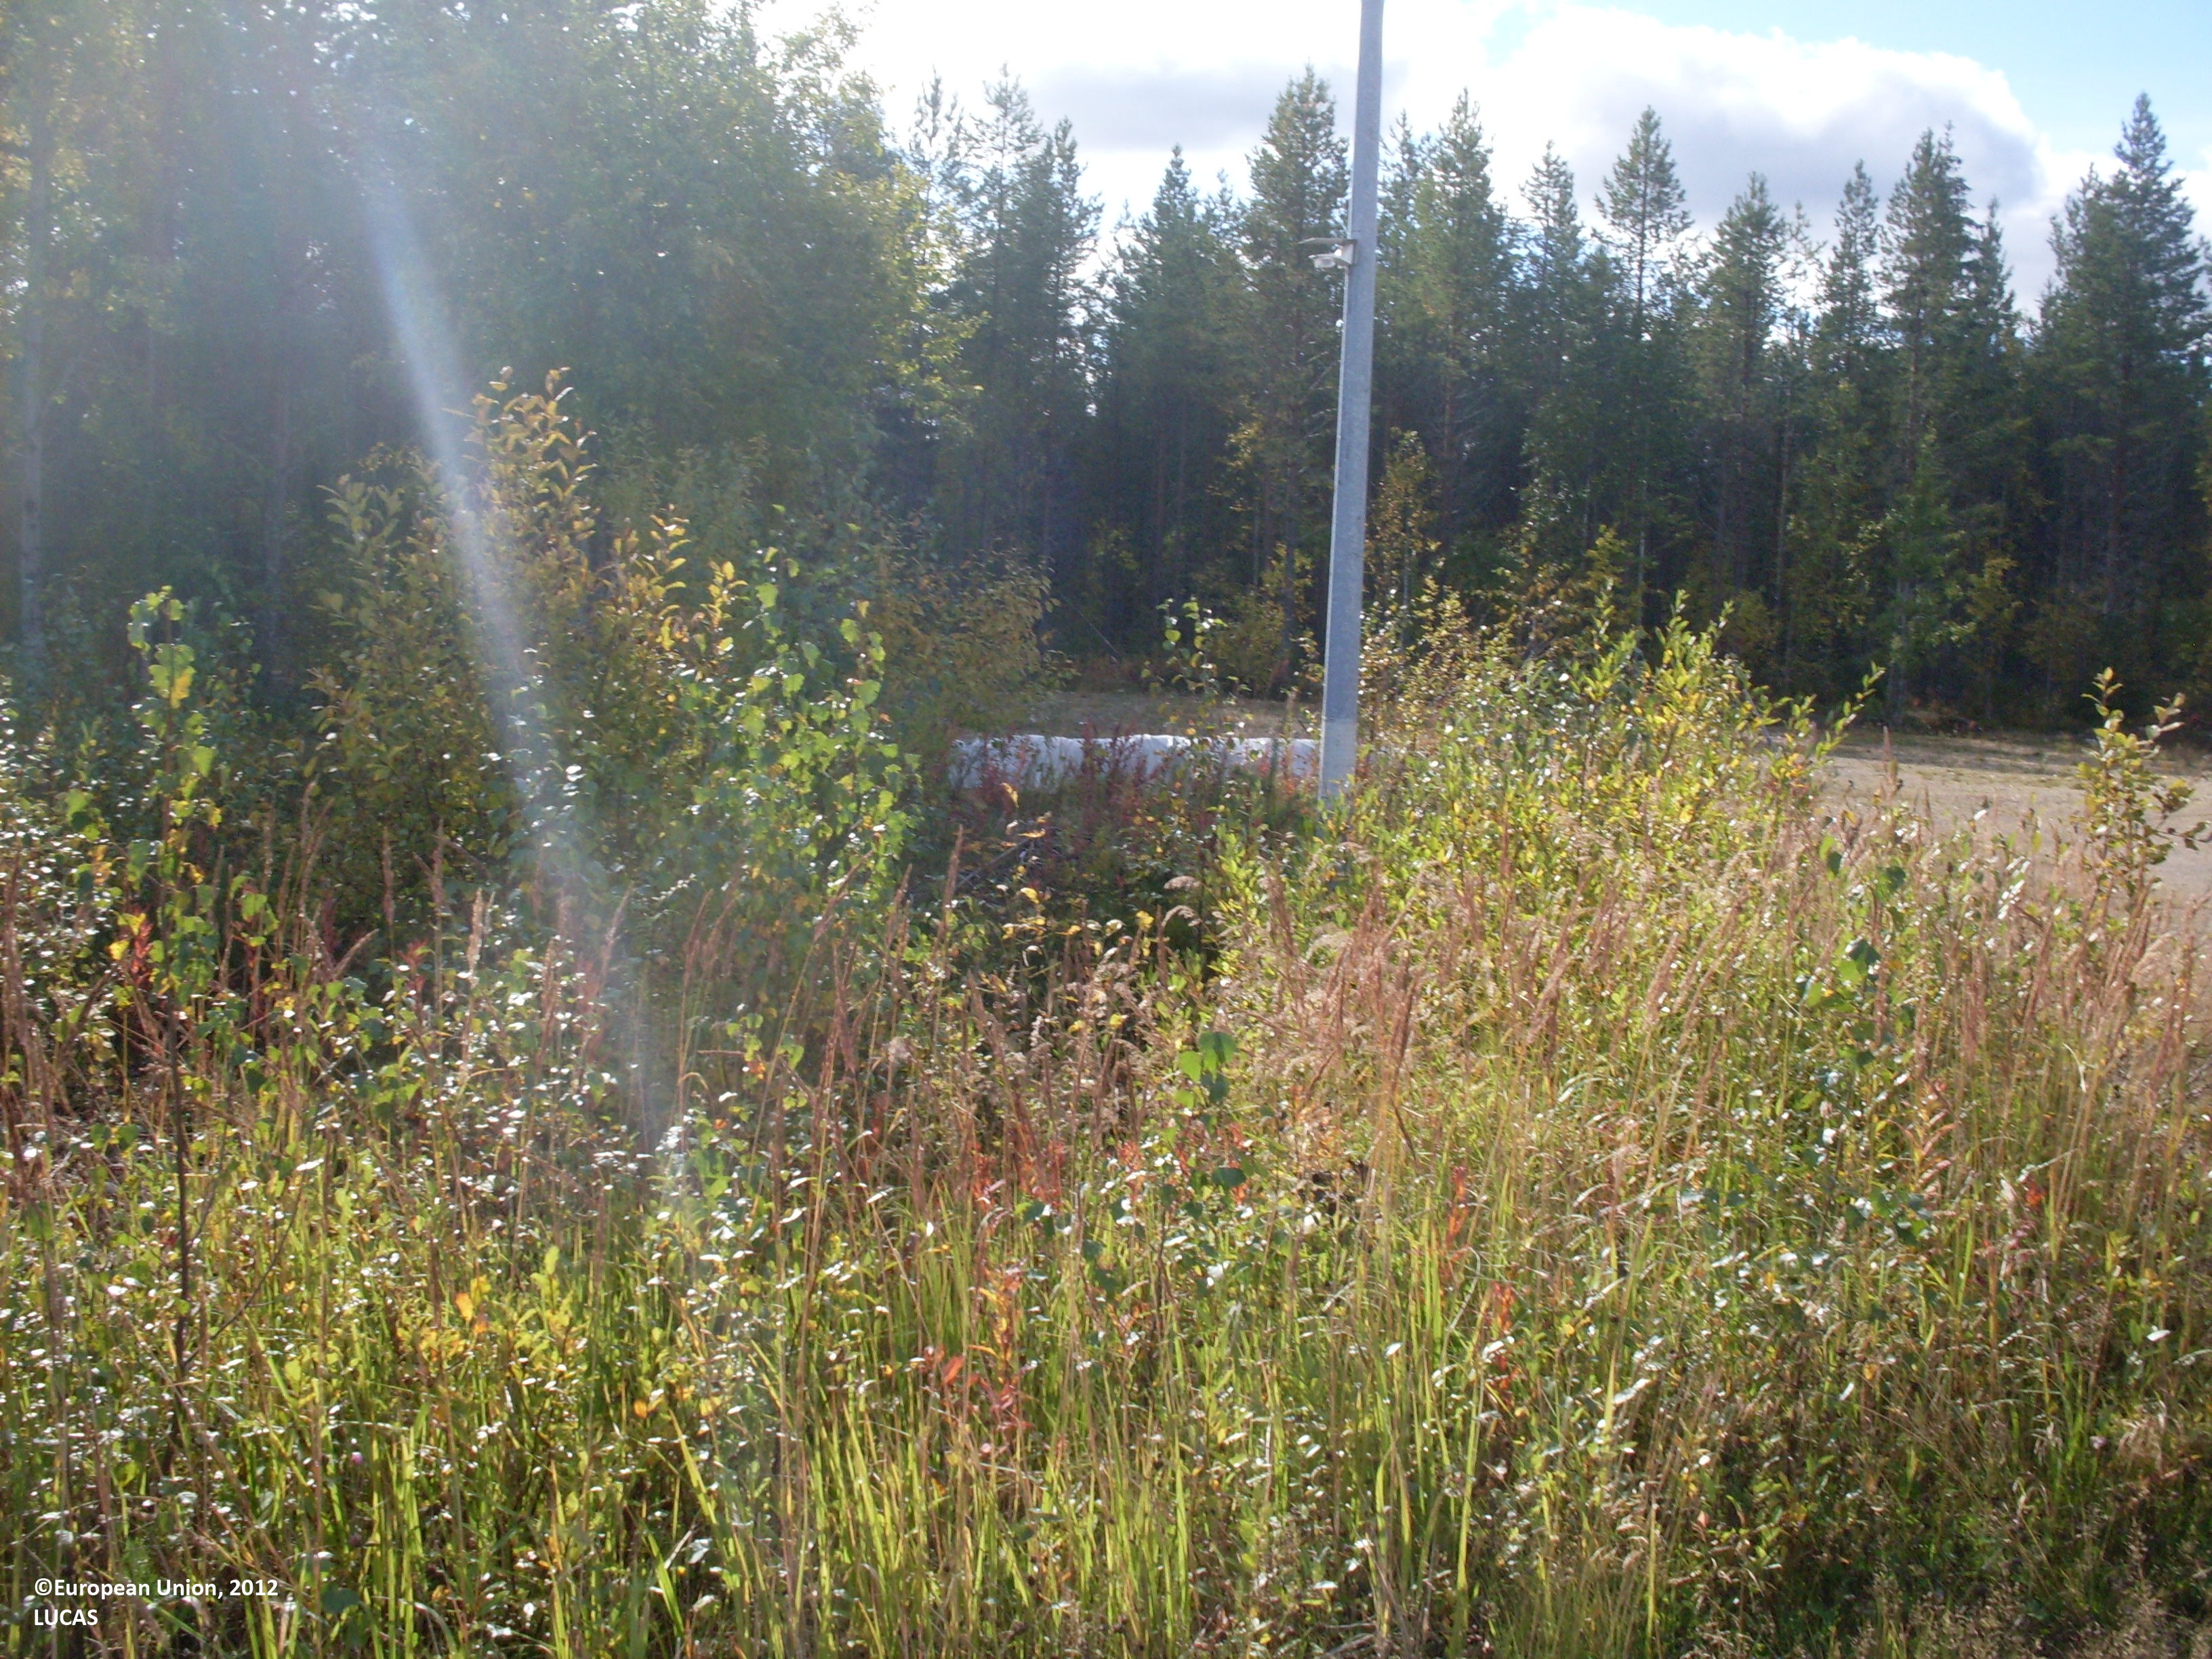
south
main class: Grassland
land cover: Grassland without tree/shrub cover
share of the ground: > 75 %
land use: Abandoned areas
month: September
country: FI
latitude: 64.0470
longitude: 29.3635
